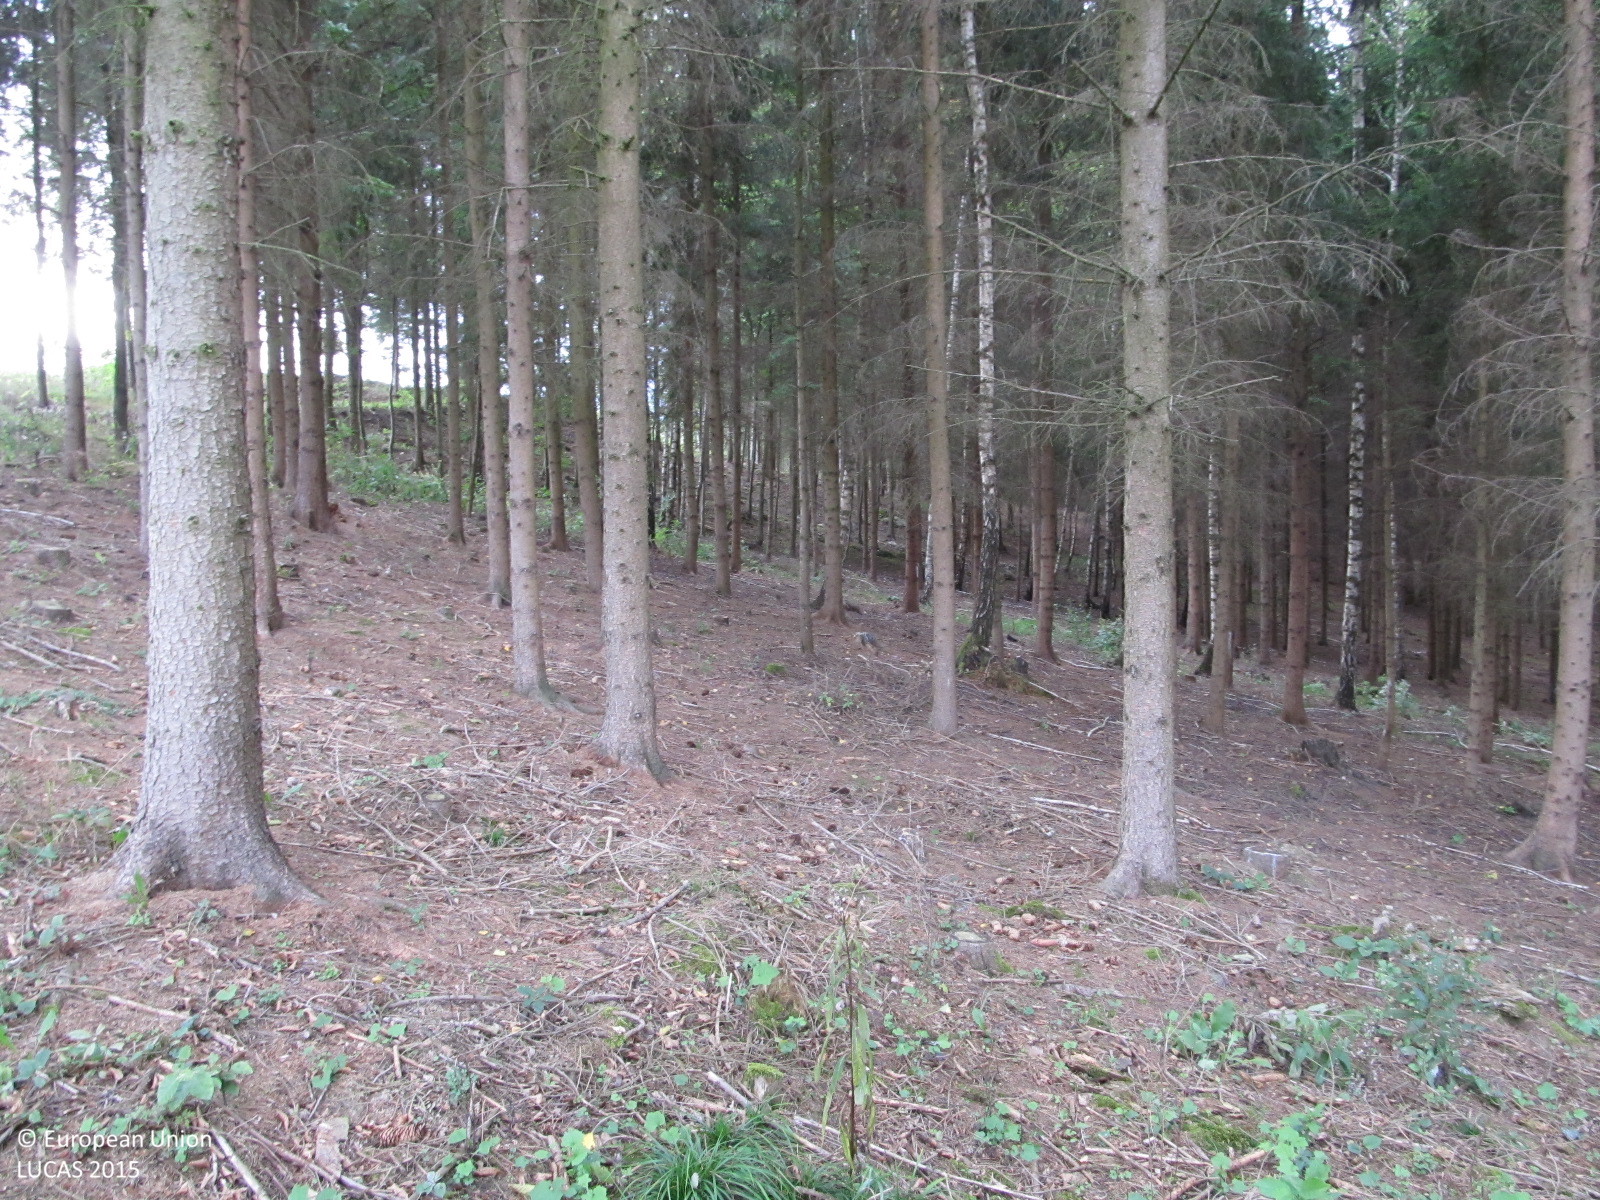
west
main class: Woodland
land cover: Spruce dominated coniferous woodland
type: hemiboreal forest and nemoral coniferous forest and mixed broadleaved-coniferous forest
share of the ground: > 75 %
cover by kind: coniferous forest trees 80 %, unconsolidated bare surface 20 %
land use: Forestry
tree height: > 5 m
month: September
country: AT
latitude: 48.6108
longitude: 15.4688
